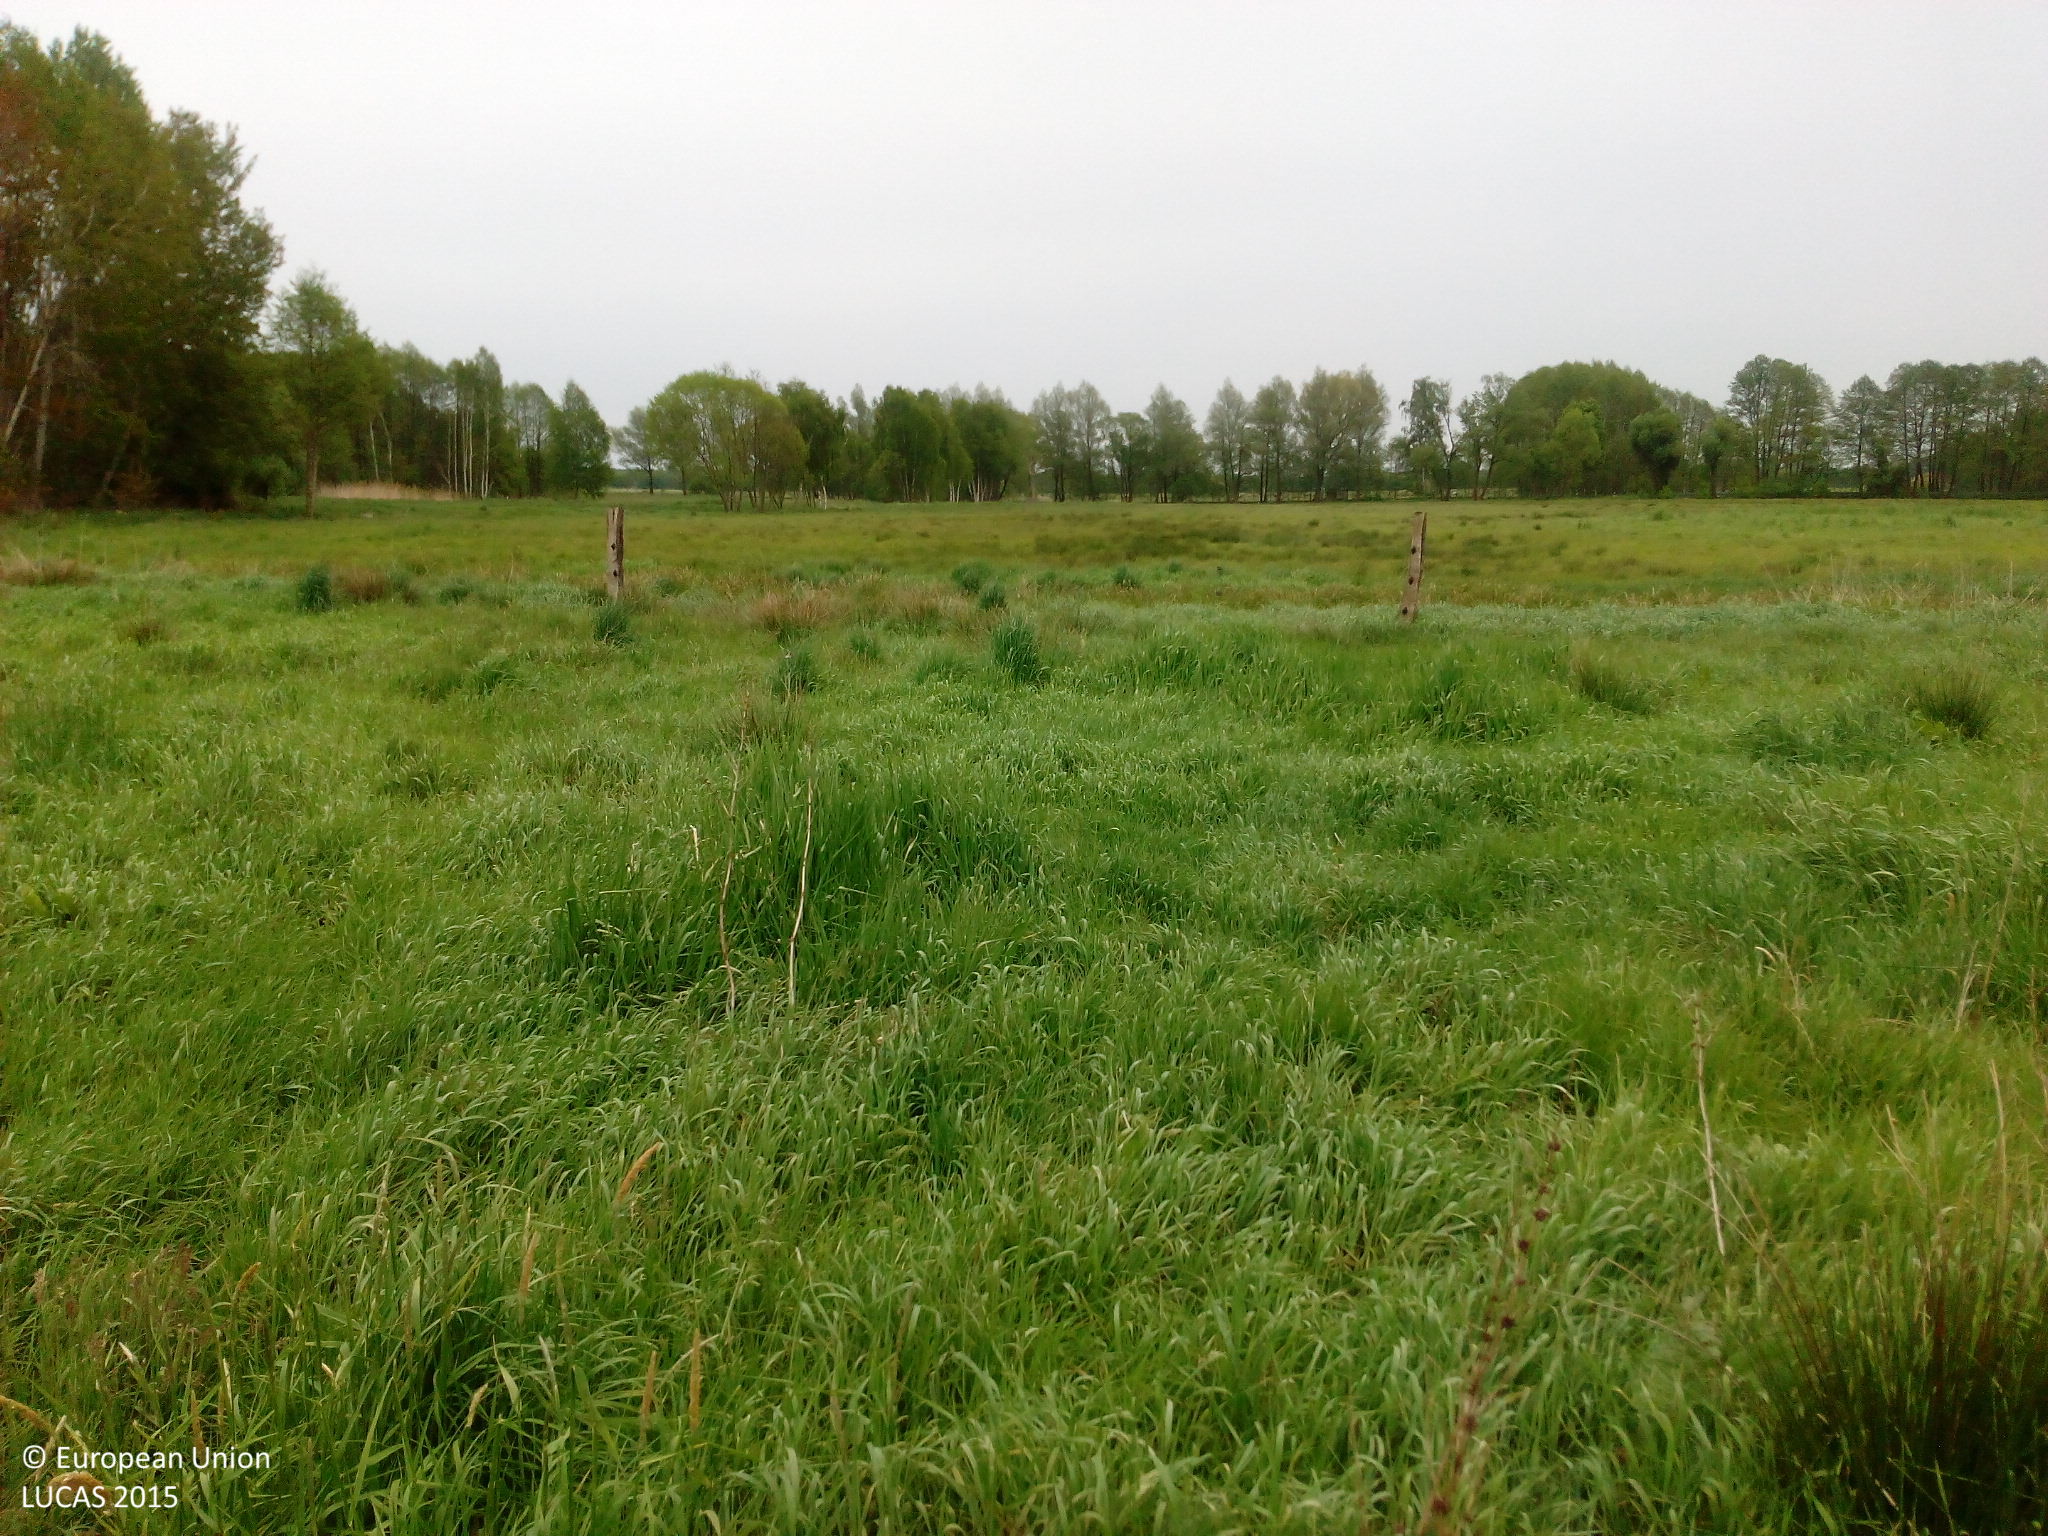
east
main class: Grassland
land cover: Grassland without tree/shrub cover
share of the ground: > 75 %
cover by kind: herbaceous plants 100 %
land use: Agriculture (excluding fallow land and kitchen gardens)
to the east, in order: Grassland without tree/shrub cover; Fences; Grassland without tree/shrub cover; Ditches and canals; Grassland without tree/shrub cover; Abandoned hedges; Ditches and canals; Spontaneously vegetated surfaces; Grassland without tree/shrub cover
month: May
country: DE
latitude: 52.1583
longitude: 13.0550
